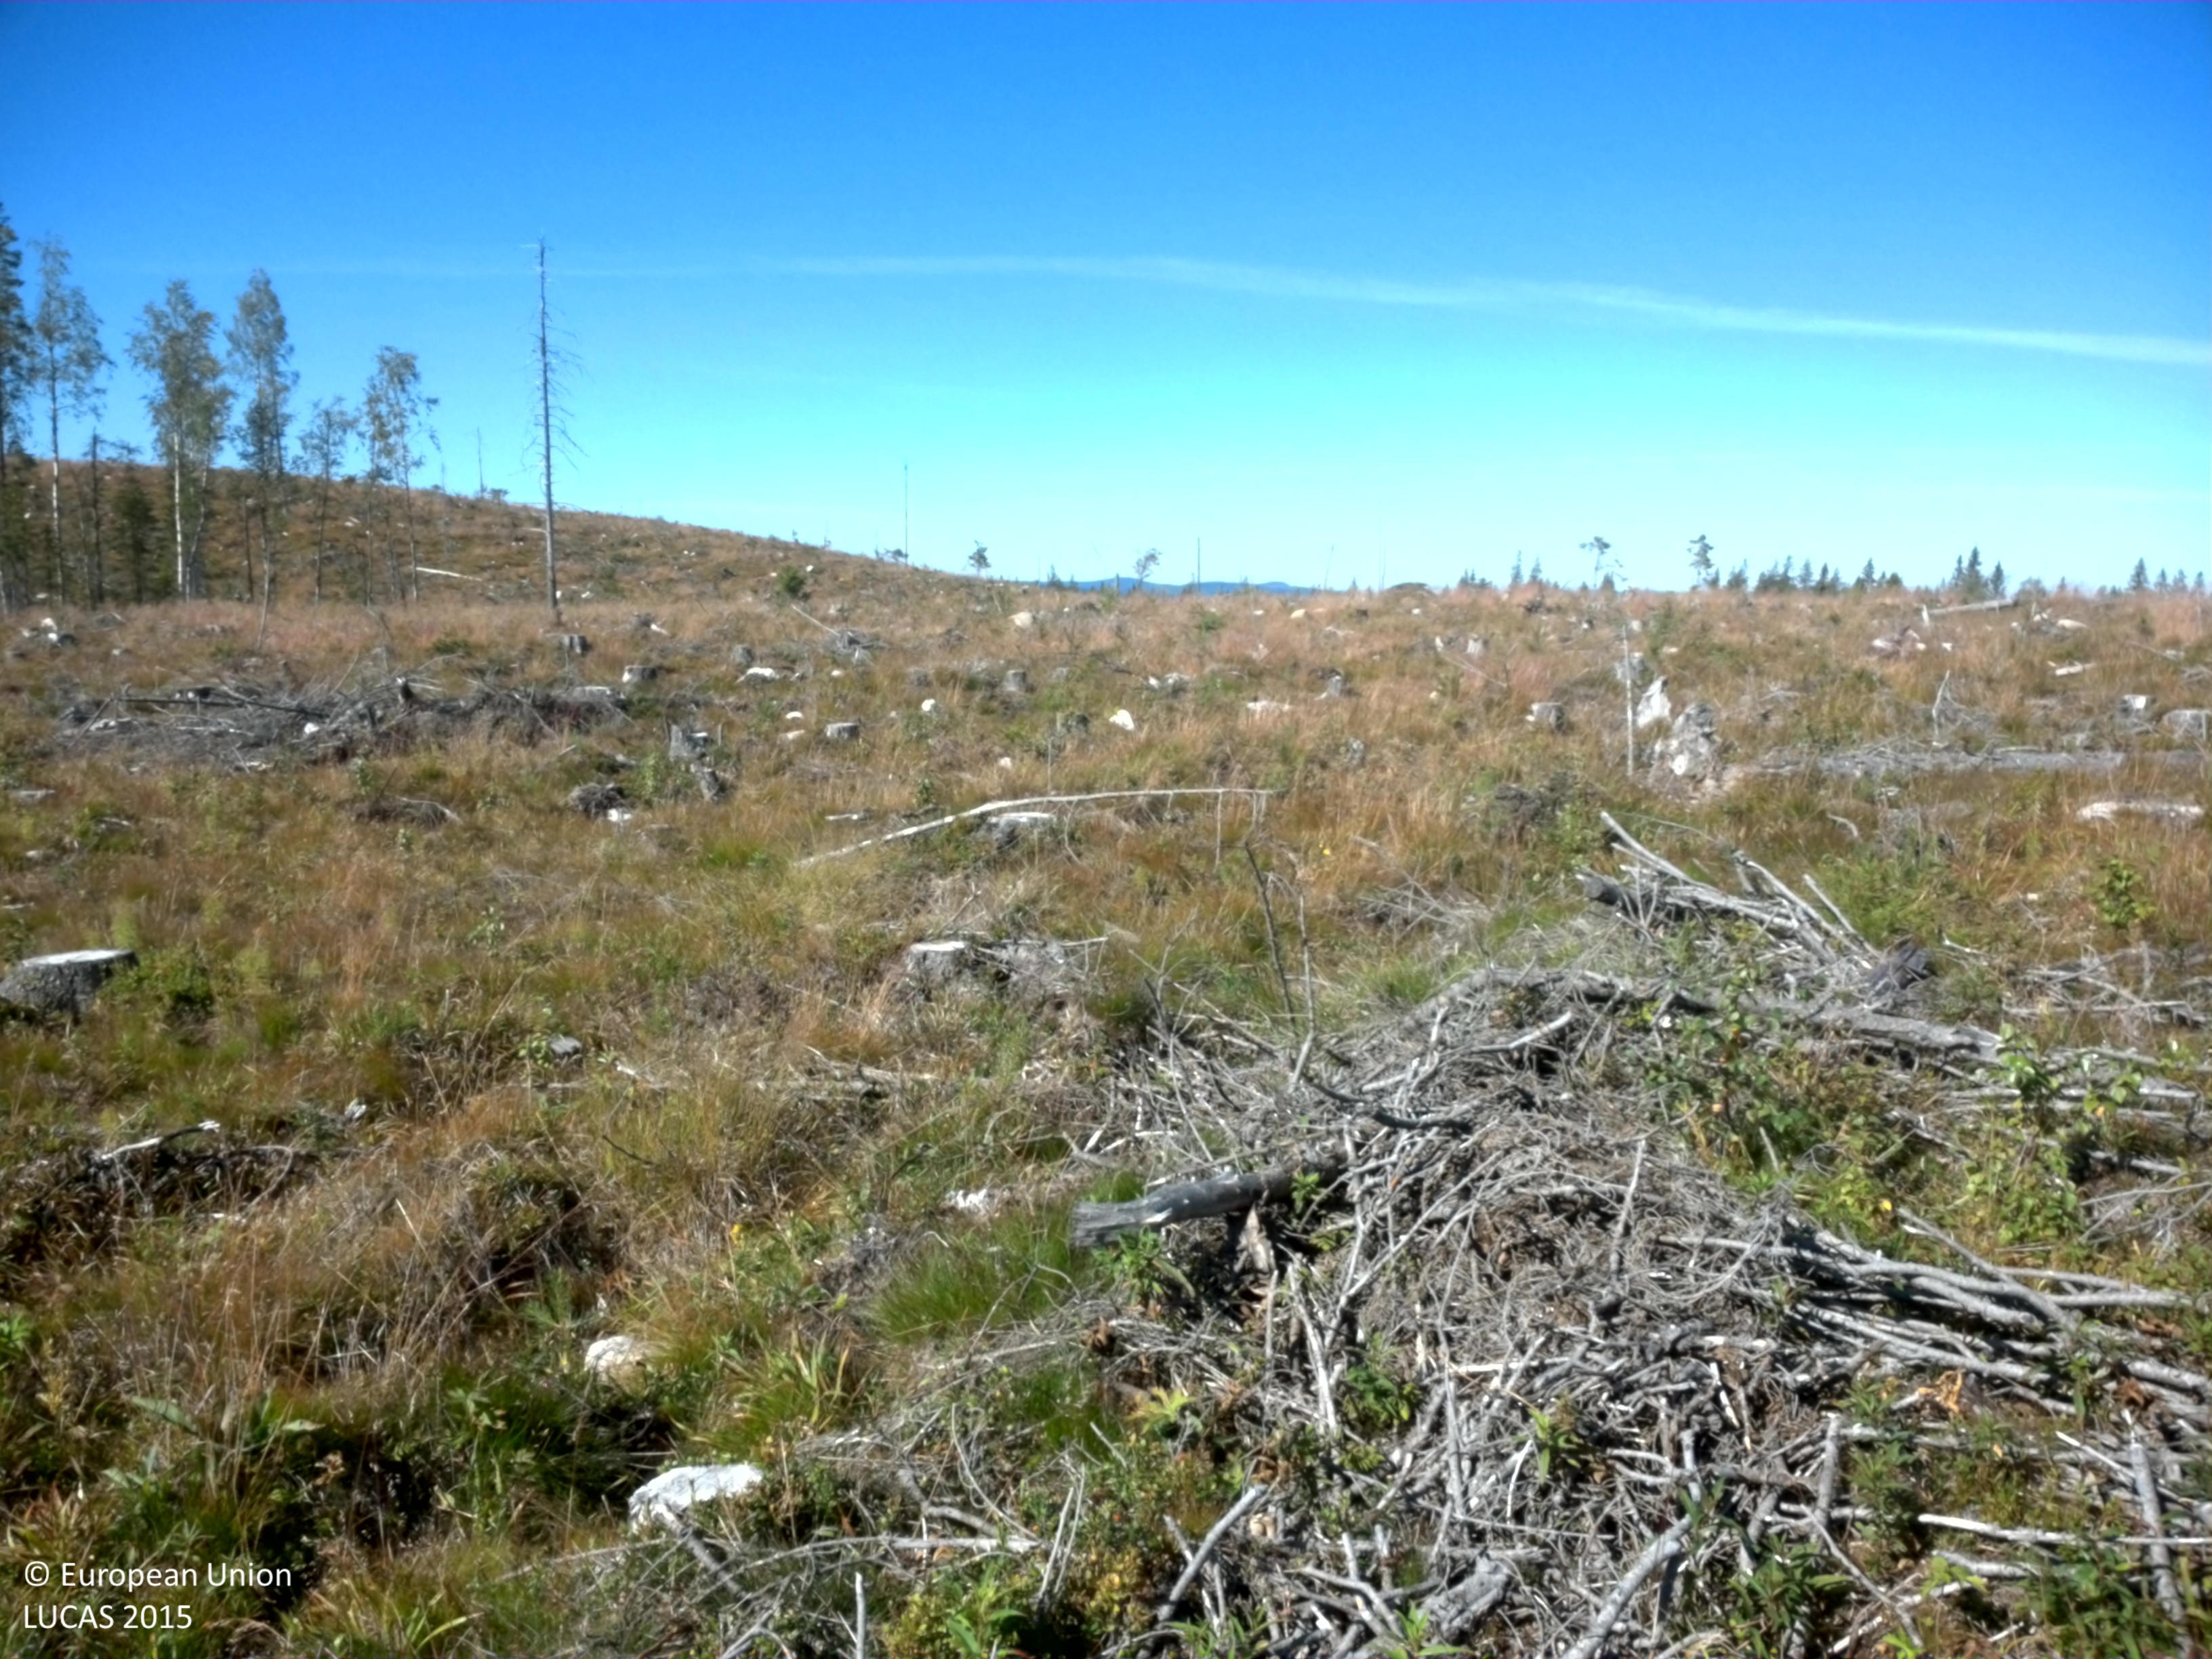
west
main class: Grassland
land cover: Grassland with sparse tree/shrub cover
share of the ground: > 75 %
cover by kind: herbaceous plants 85 %, shrubs 10 %, broadleaved forest trees 5 %
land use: Forestry
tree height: < 5 m
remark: Clear cut
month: August
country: SE
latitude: 64.3039
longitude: 18.7141
